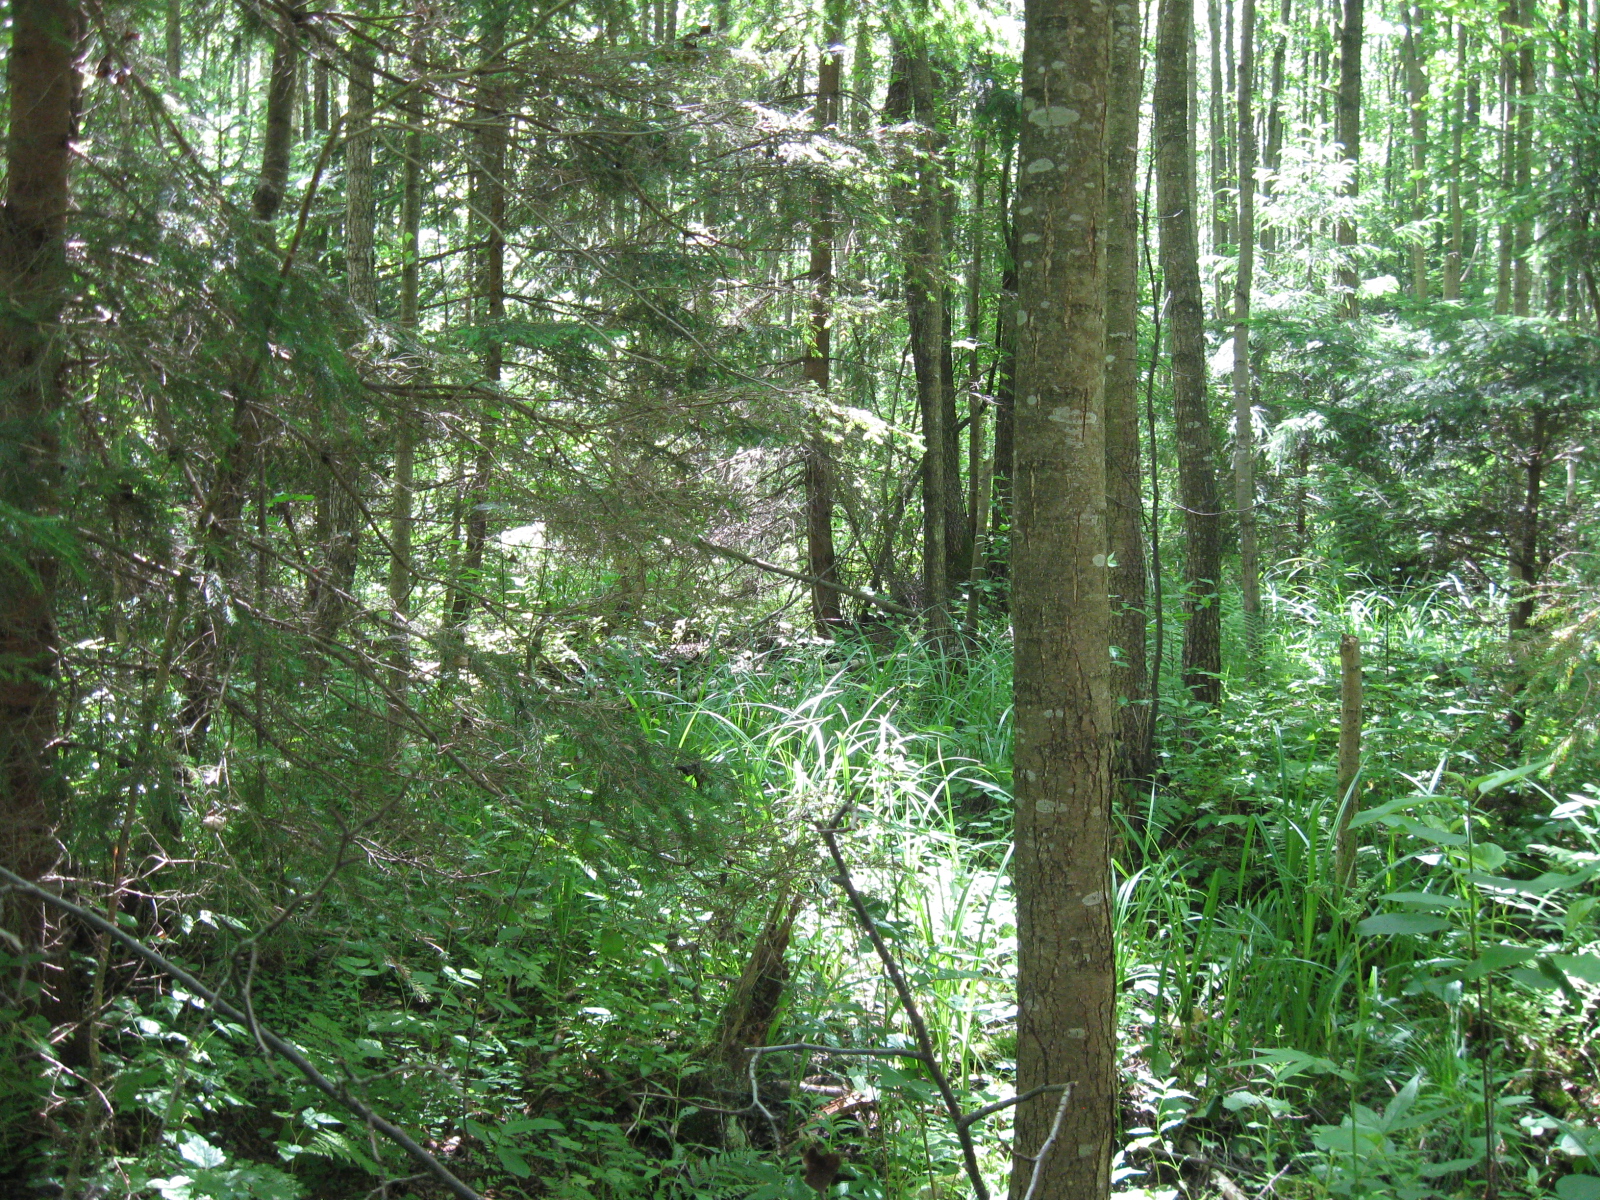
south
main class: Woodland
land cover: Spruce dominated mixed woodland
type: hemiboreal forest and nemoral coniferous forest and mixed broadleaved-coniferous forest
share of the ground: > 75 %
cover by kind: broadleaved forest trees 70 %, coniferous forest trees 30 %
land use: Forestry
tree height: > 5 m
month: June
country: LT
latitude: 53.9631
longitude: 24.2275
